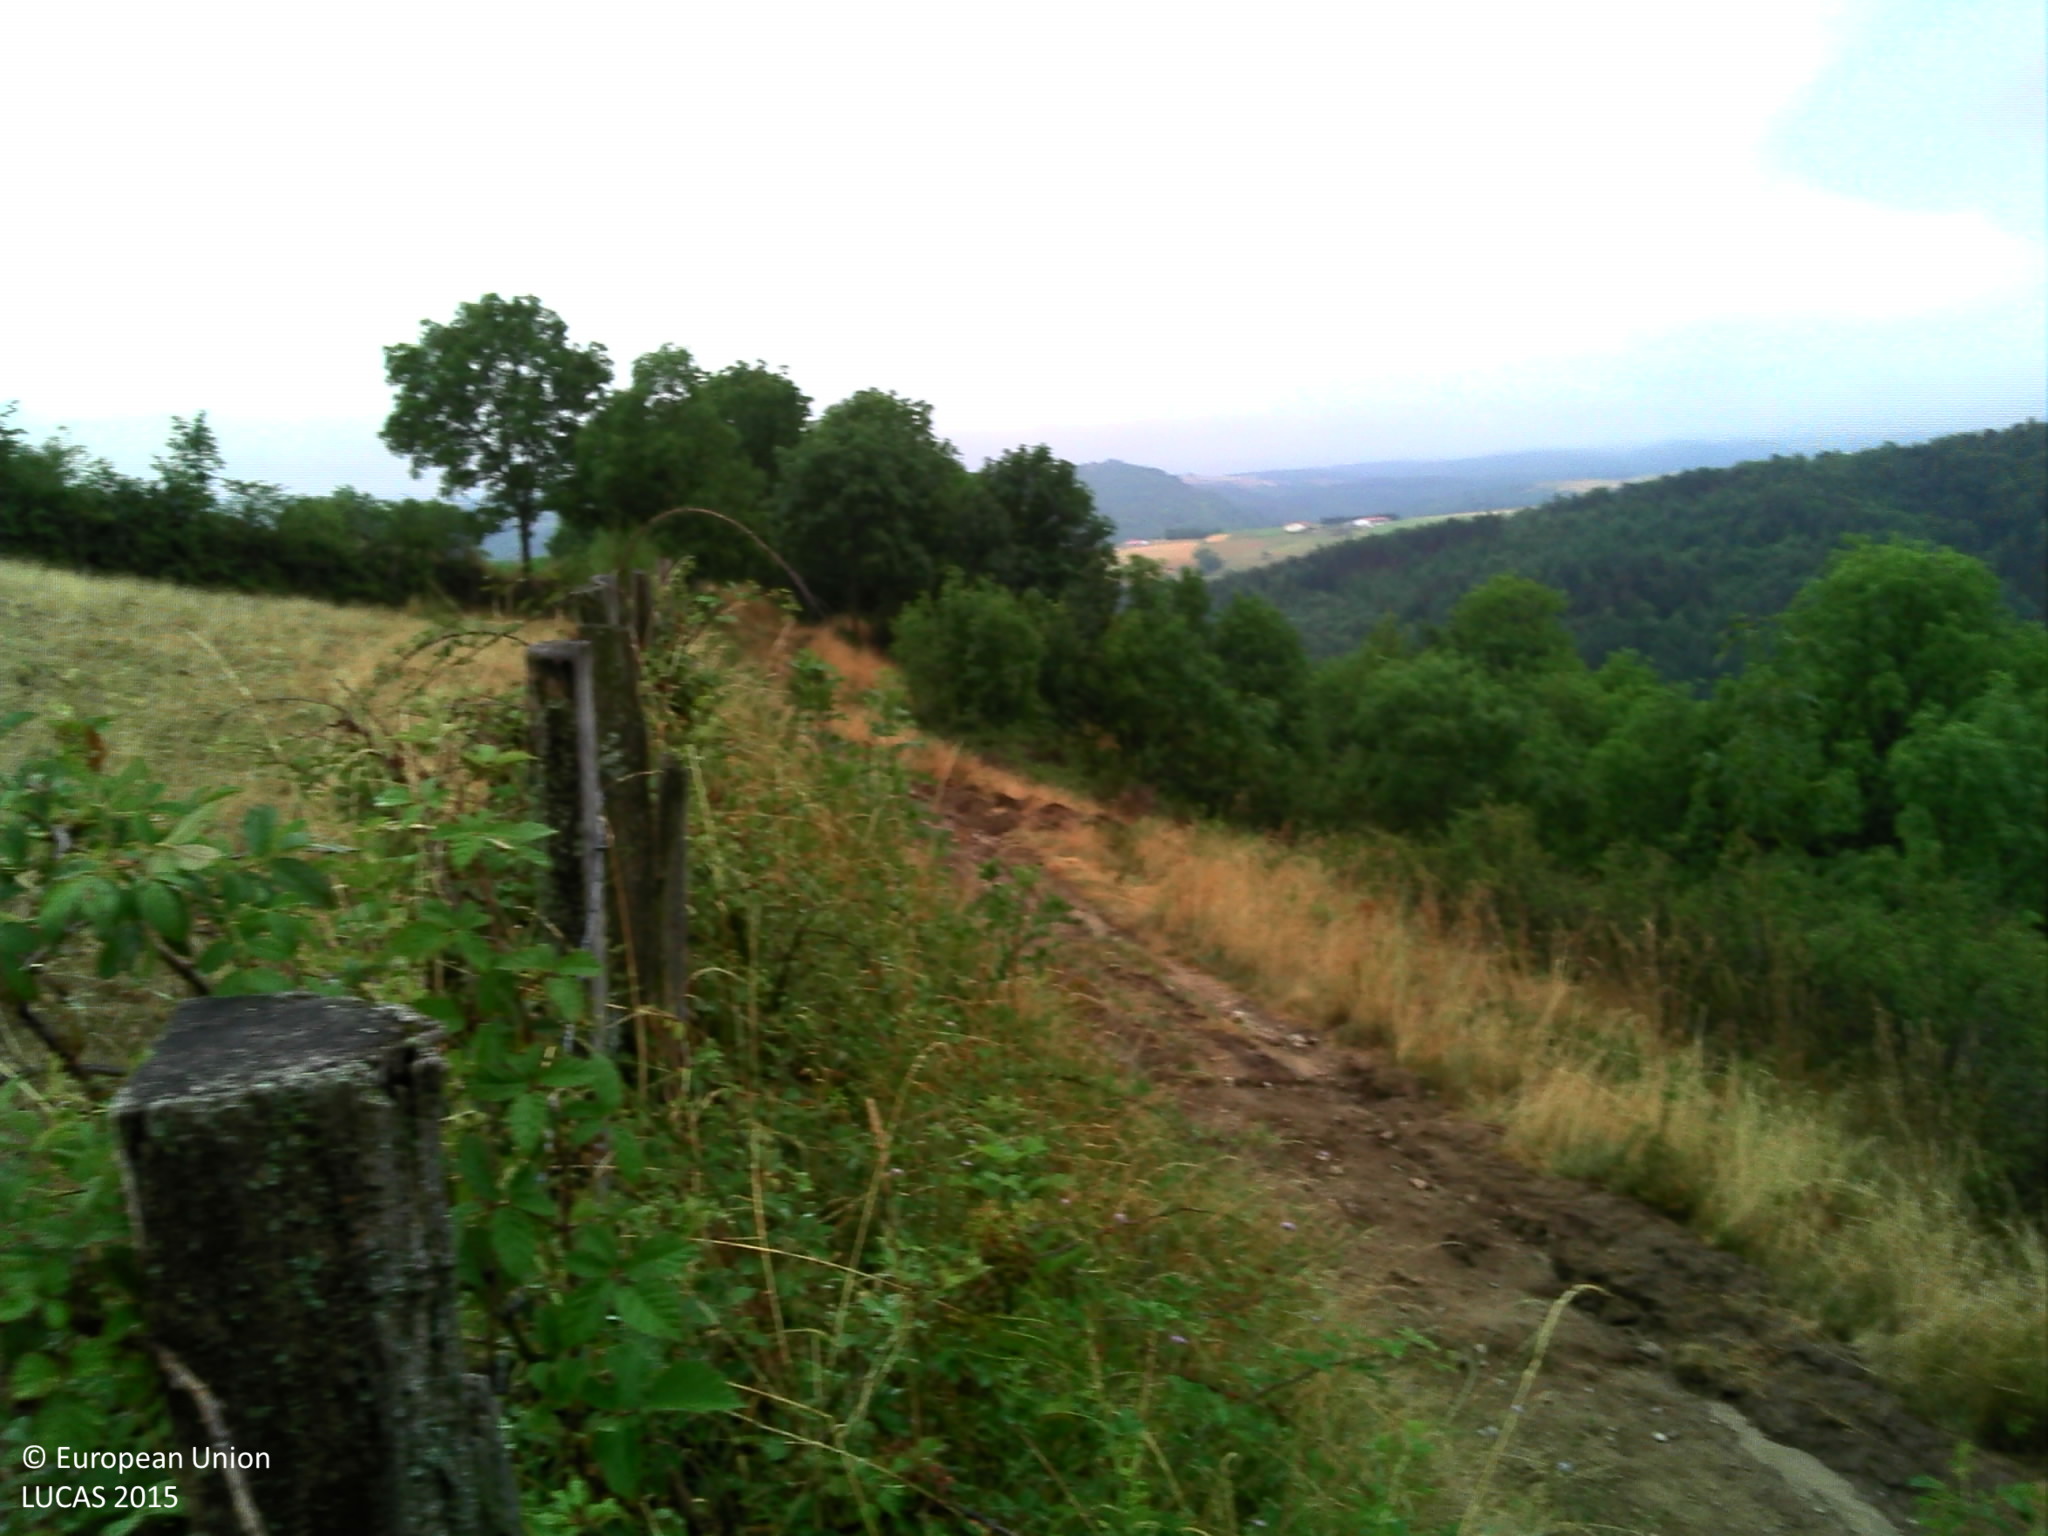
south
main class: Grassland
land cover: Grassland without tree/shrub cover
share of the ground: > 75 %
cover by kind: herbaceous plants 90 %, lichens and mosses 10 %
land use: Agriculture (excluding fallow land and kitchen gardens)
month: July
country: FR
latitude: 45.5022
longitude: 4.1032
